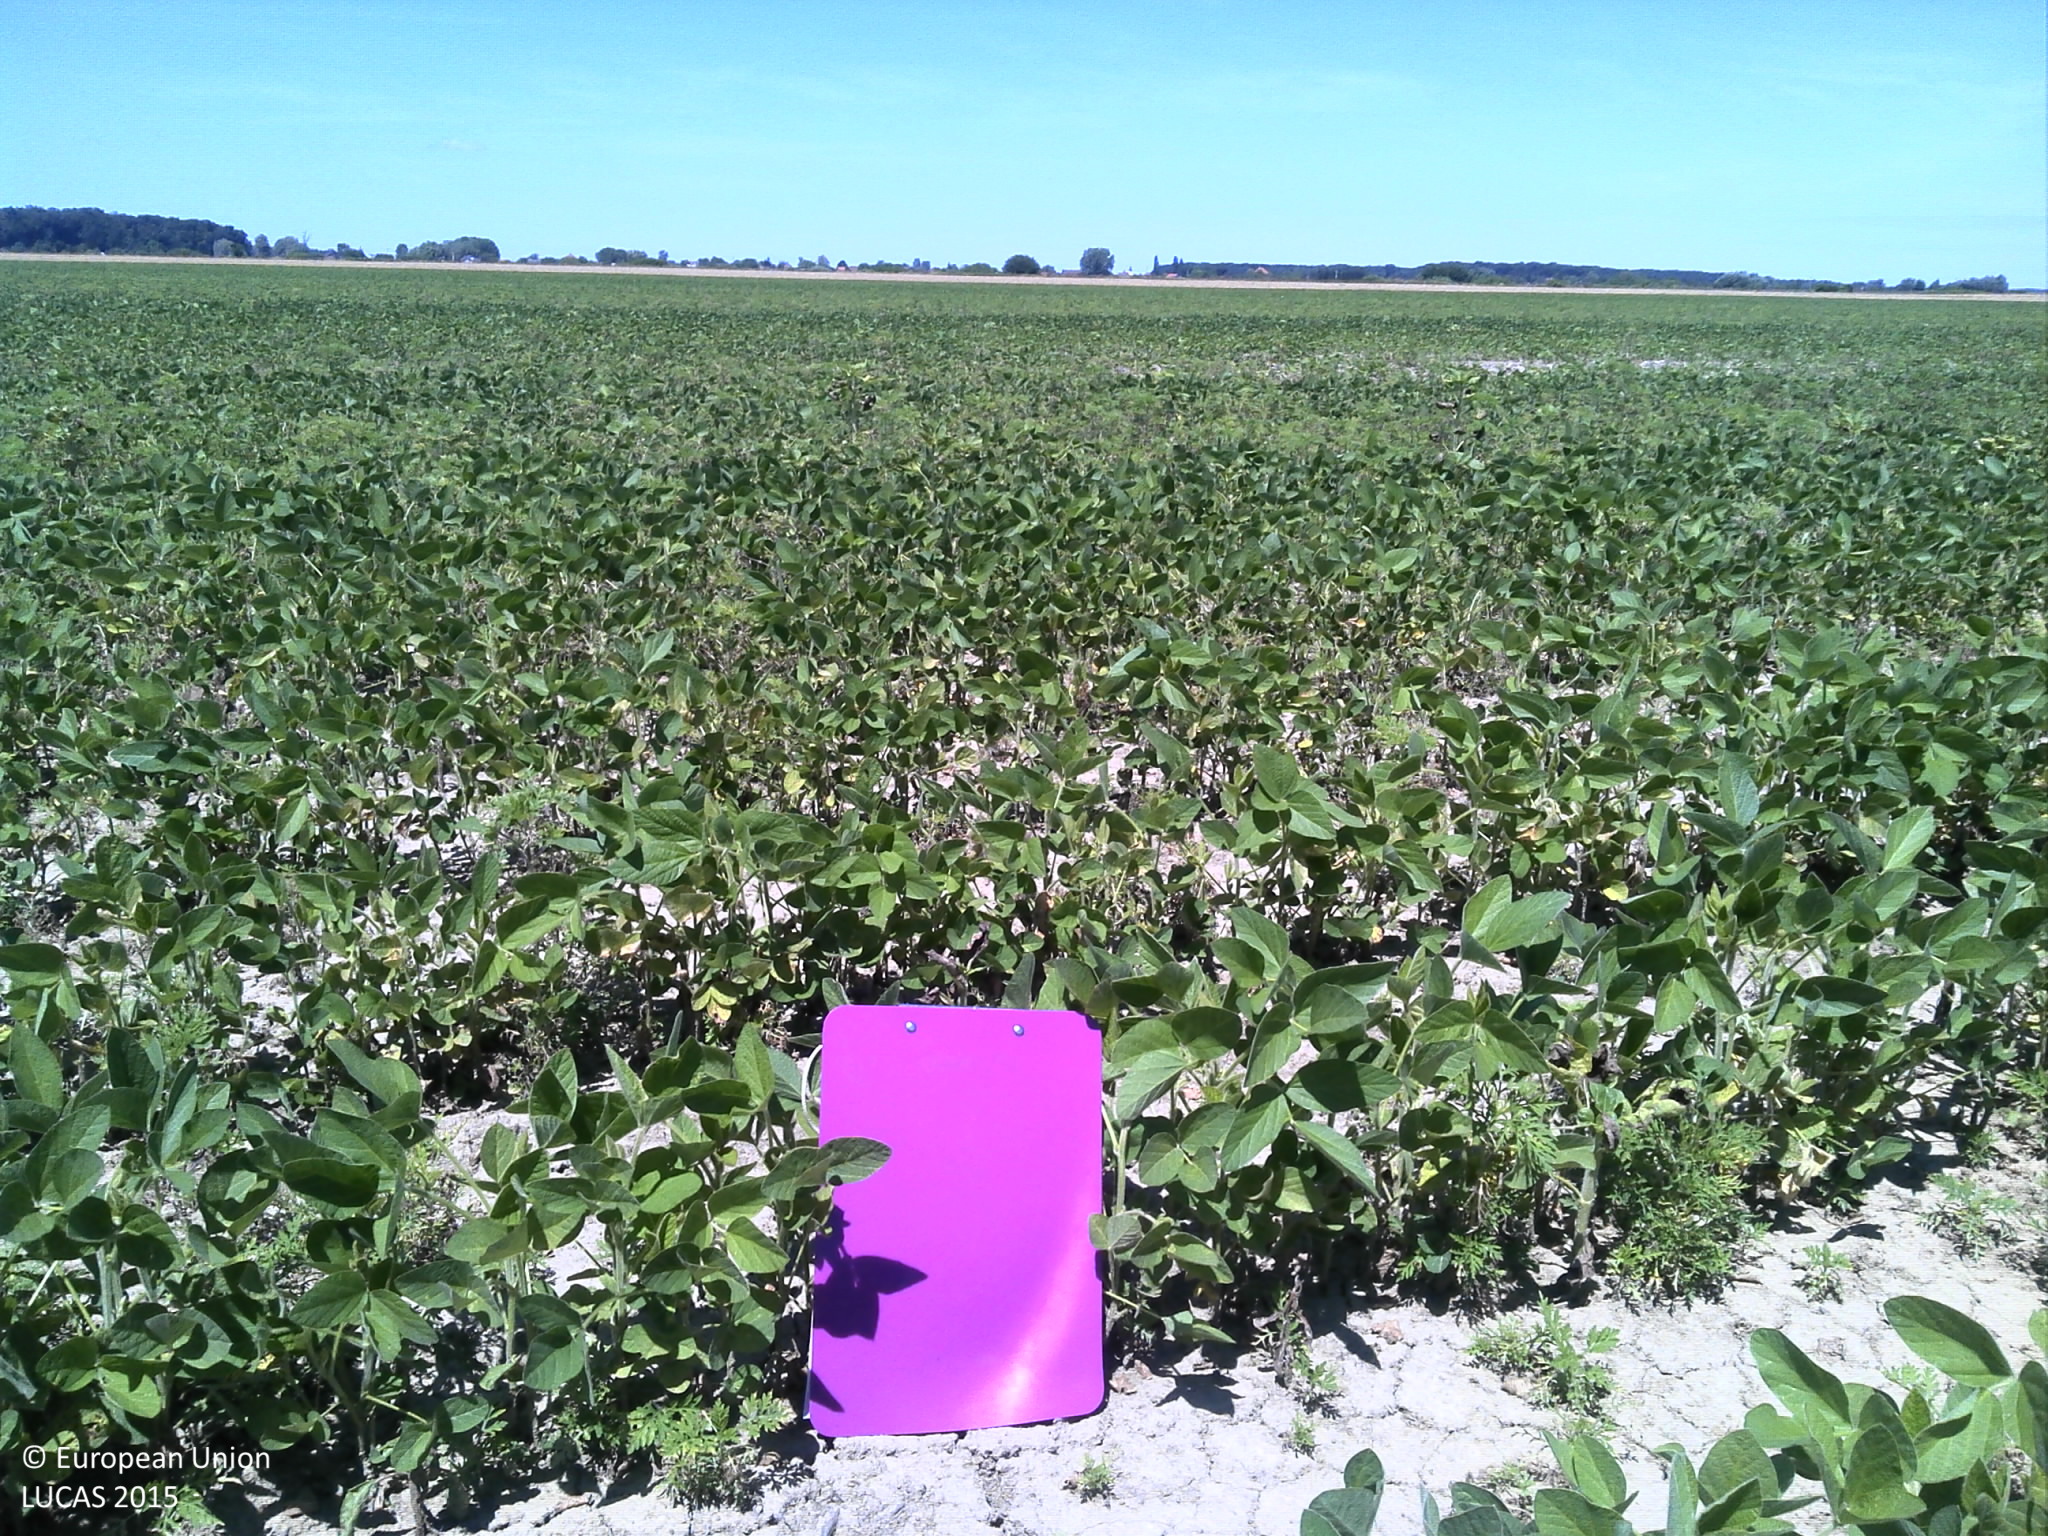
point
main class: Cropland
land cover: Soya
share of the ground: 50 - 75 %
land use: Agriculture (excluding fallow land and kitchen gardens)
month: June
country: HR
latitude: 45.7446
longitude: 17.9866
